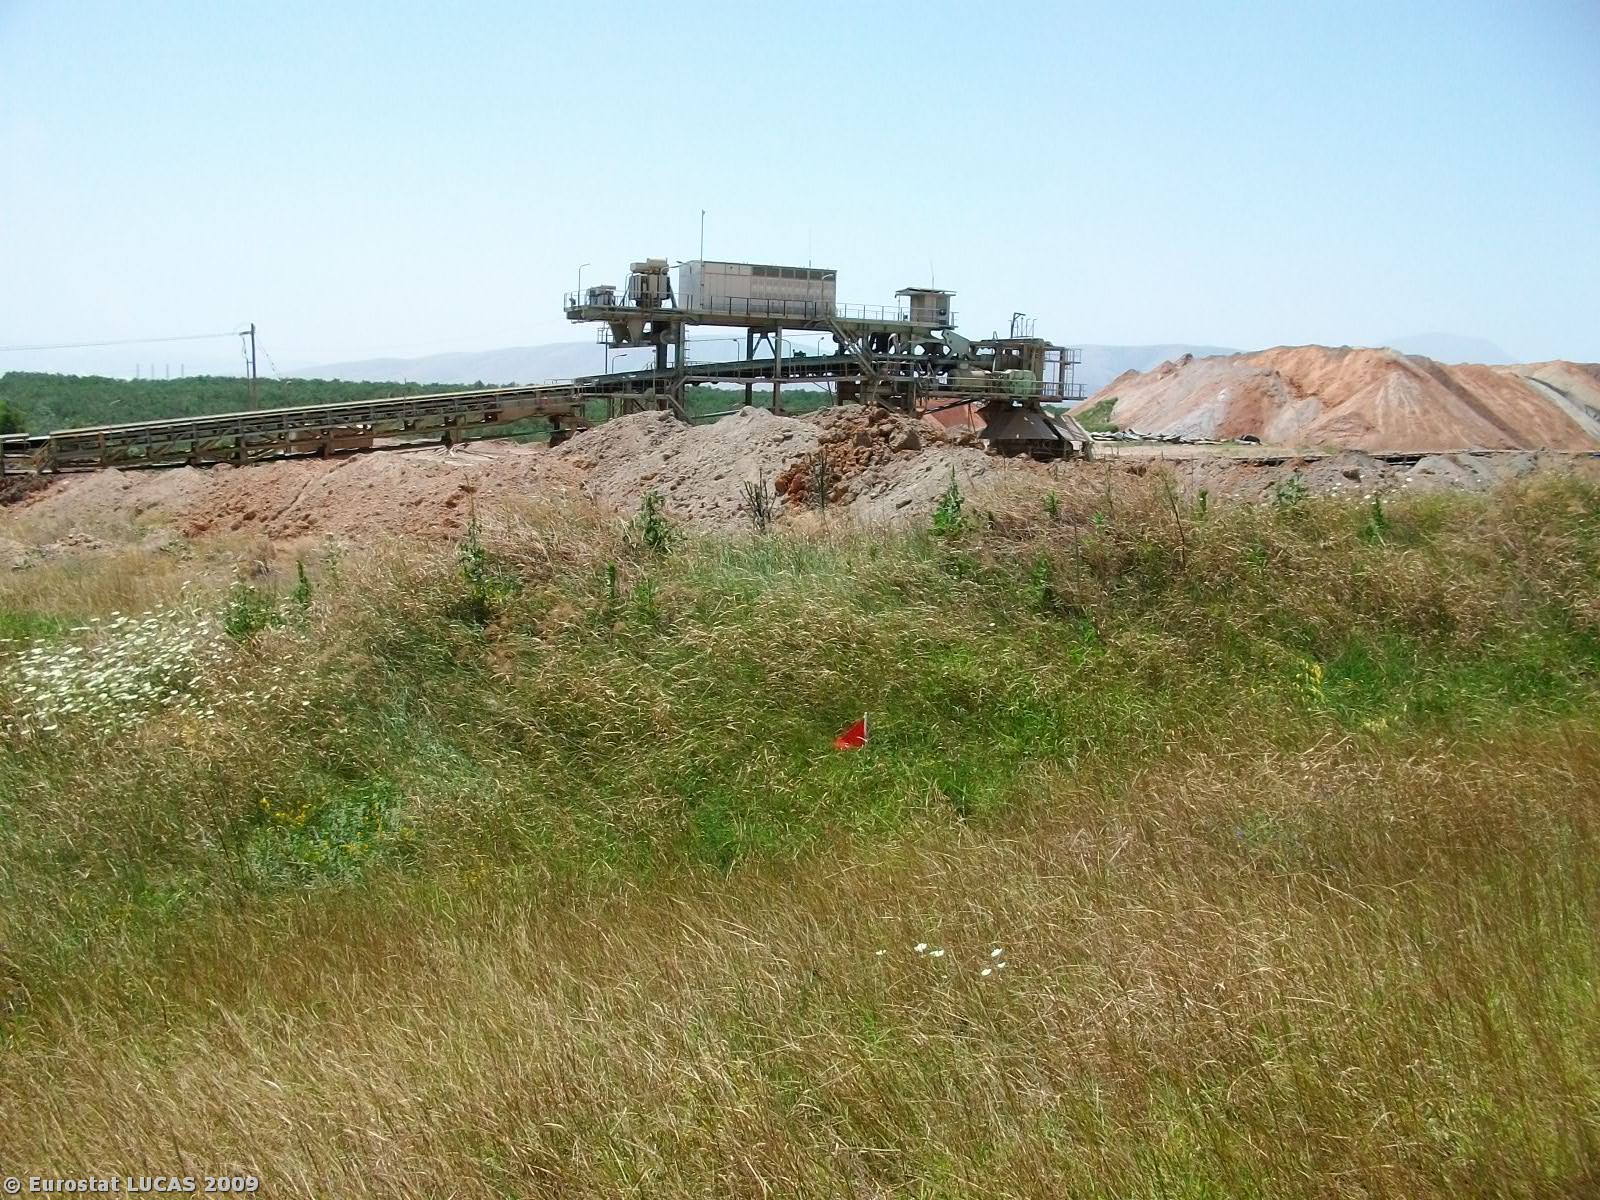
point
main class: Grassland
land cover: Grassland without tree/shrub cover
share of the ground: > 75 %
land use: Unused
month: July
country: GR
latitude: 40.4629
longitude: 21.8226
